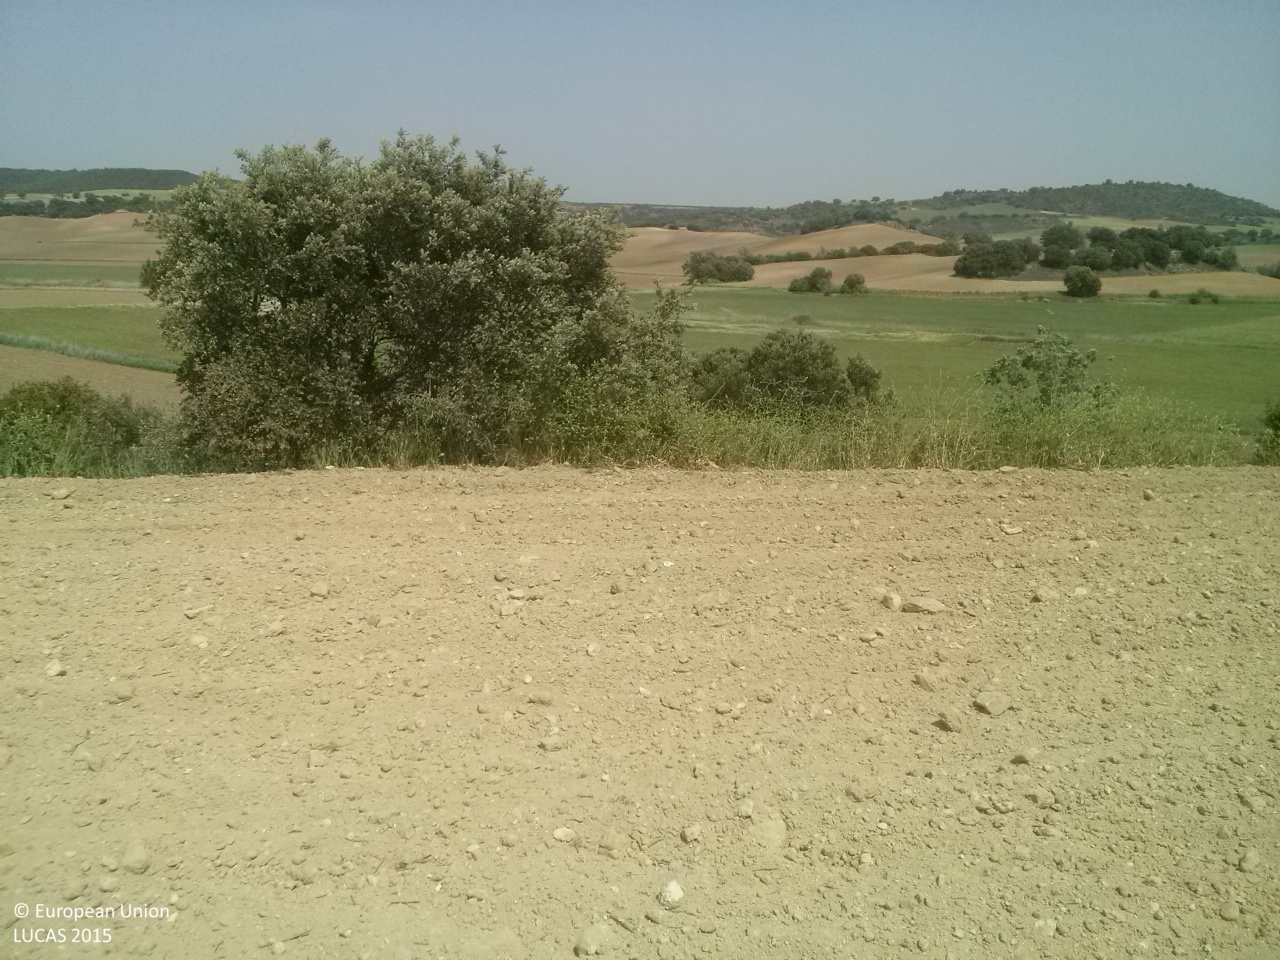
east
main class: Cropland
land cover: Sunflower
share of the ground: < 10 %
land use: Agriculture (excluding fallow land and kitchen gardens)
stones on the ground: 10 - 25 %
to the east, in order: Sunflower; Broadleaved woodland; Sunflower; Grass margins; Ditches and canals; Grass margins; Barley; Grass margins; Rivers and streams; Grass margins; Barley
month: May
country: ES
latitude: 39.9185
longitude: -2.5242
